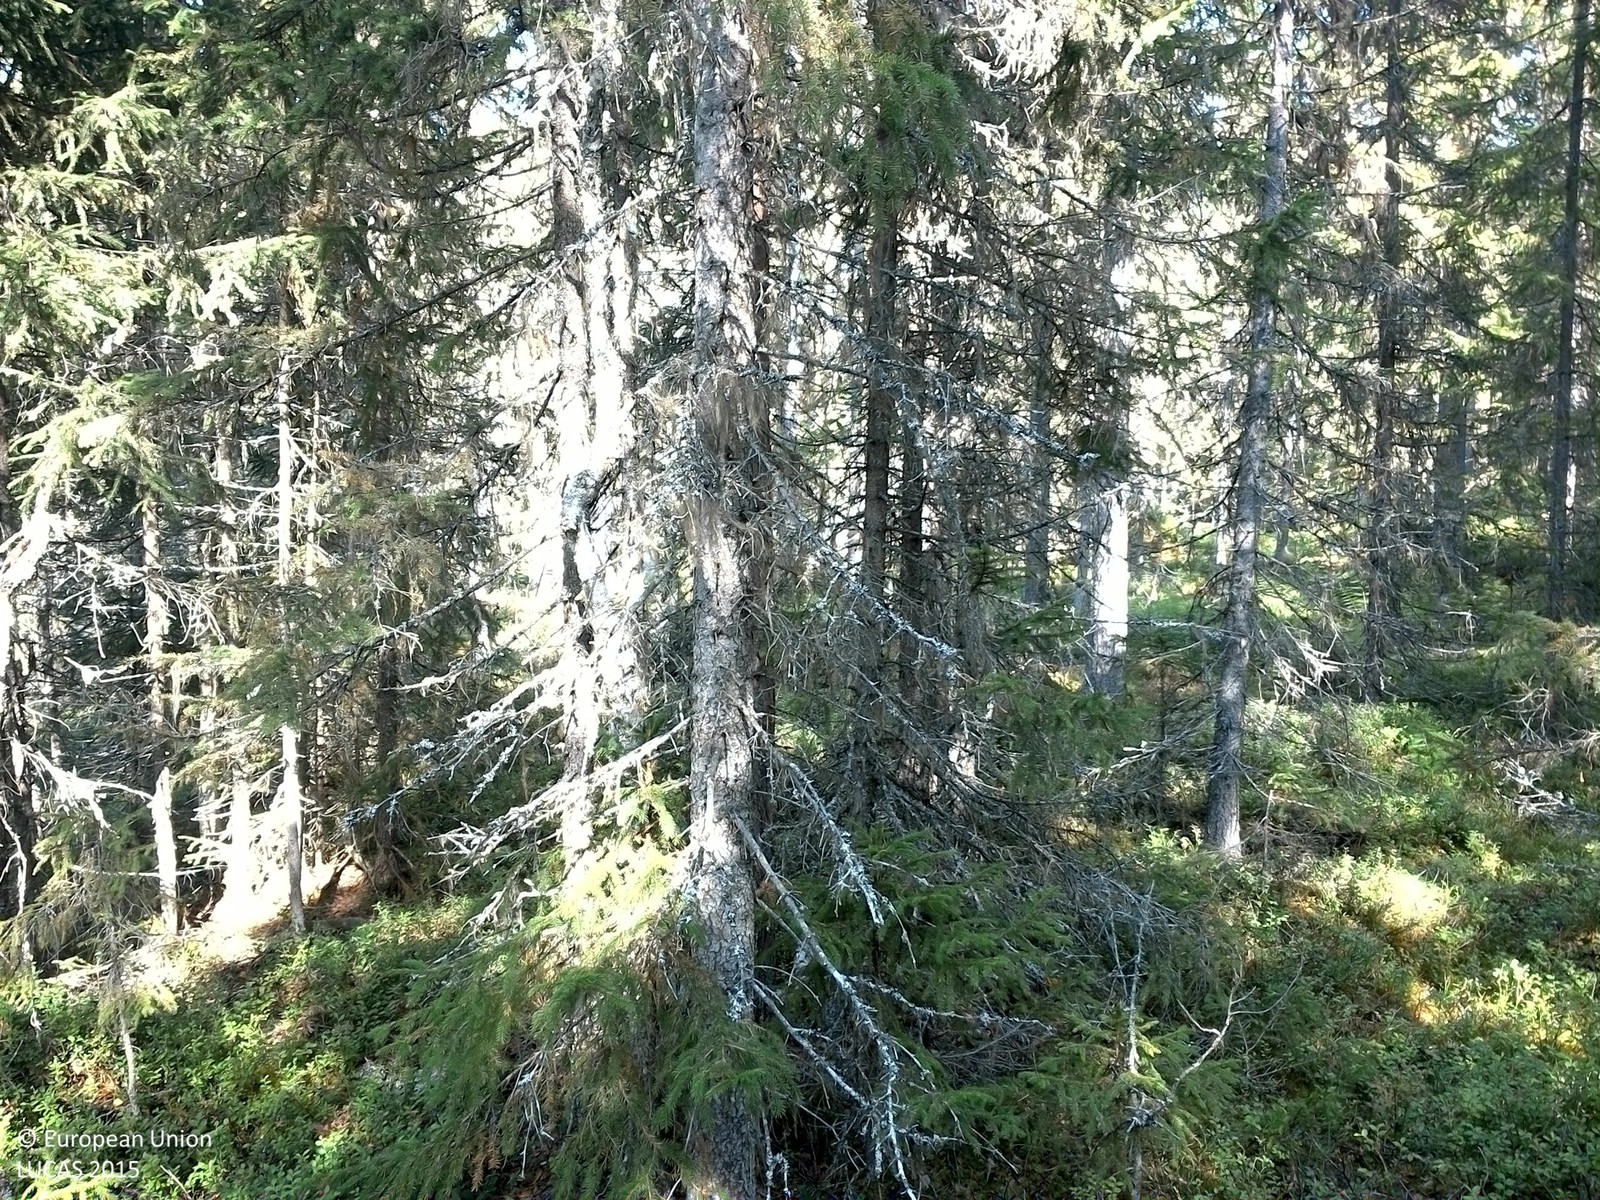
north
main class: Woodland
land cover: Spruce dominated coniferous woodland
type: boreal forest
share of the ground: 50 - 75 %
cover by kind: coniferous forest trees 60 %, shrubs 20 %, lichens and mosses 15 %, broadleaved forest trees 5 %
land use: Forestry
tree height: > 5 m
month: September
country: SE
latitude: 64.0490
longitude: 16.4633
